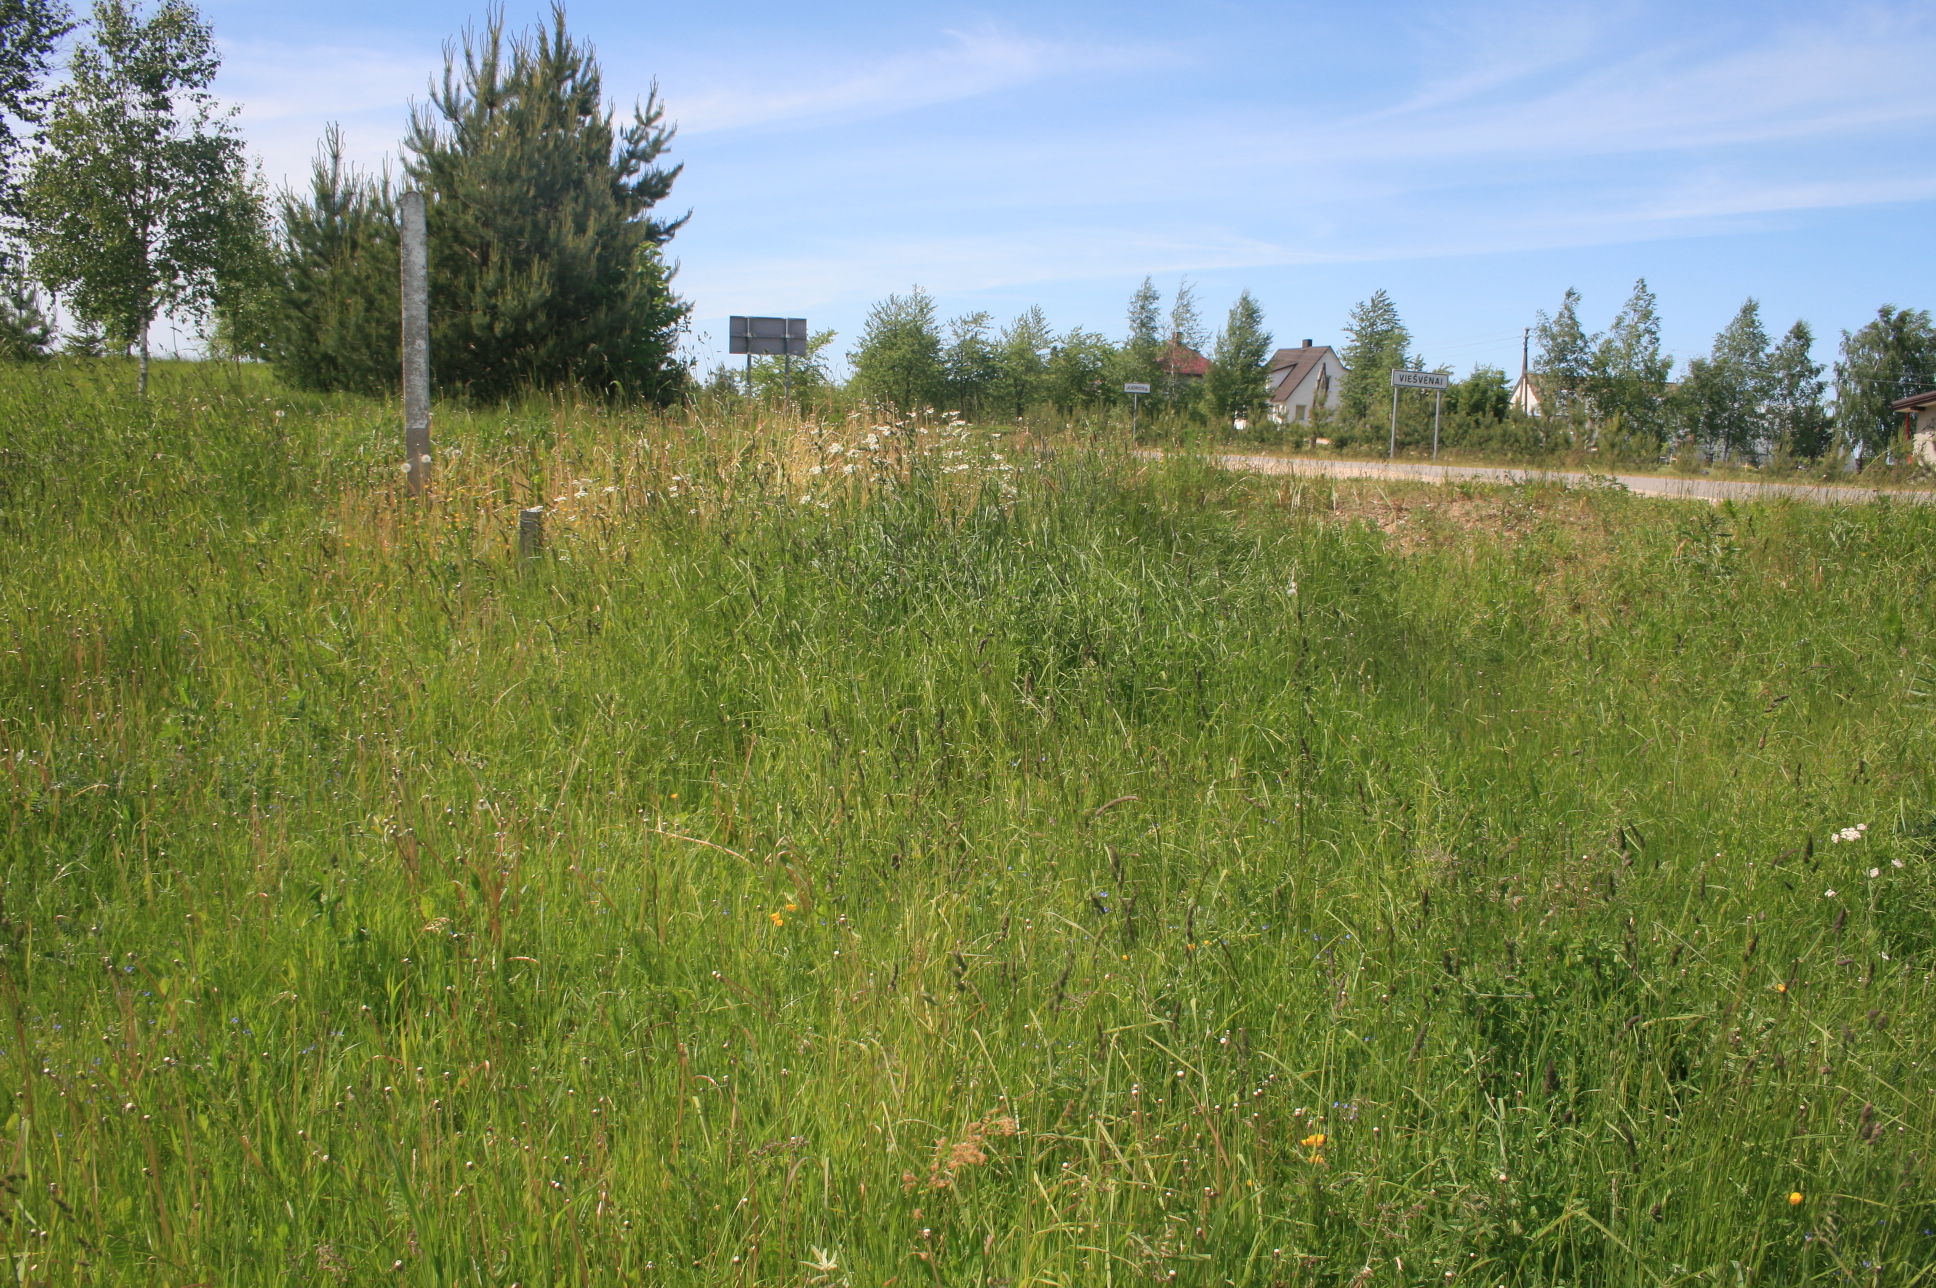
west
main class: Grassland
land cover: Grassland without tree/shrub cover
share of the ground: > 75 %
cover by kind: herbaceous plants 100 %
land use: Agriculture (excluding fallow land and kitchen gardens)
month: June
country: LT
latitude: 55.9358
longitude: 22.3351
